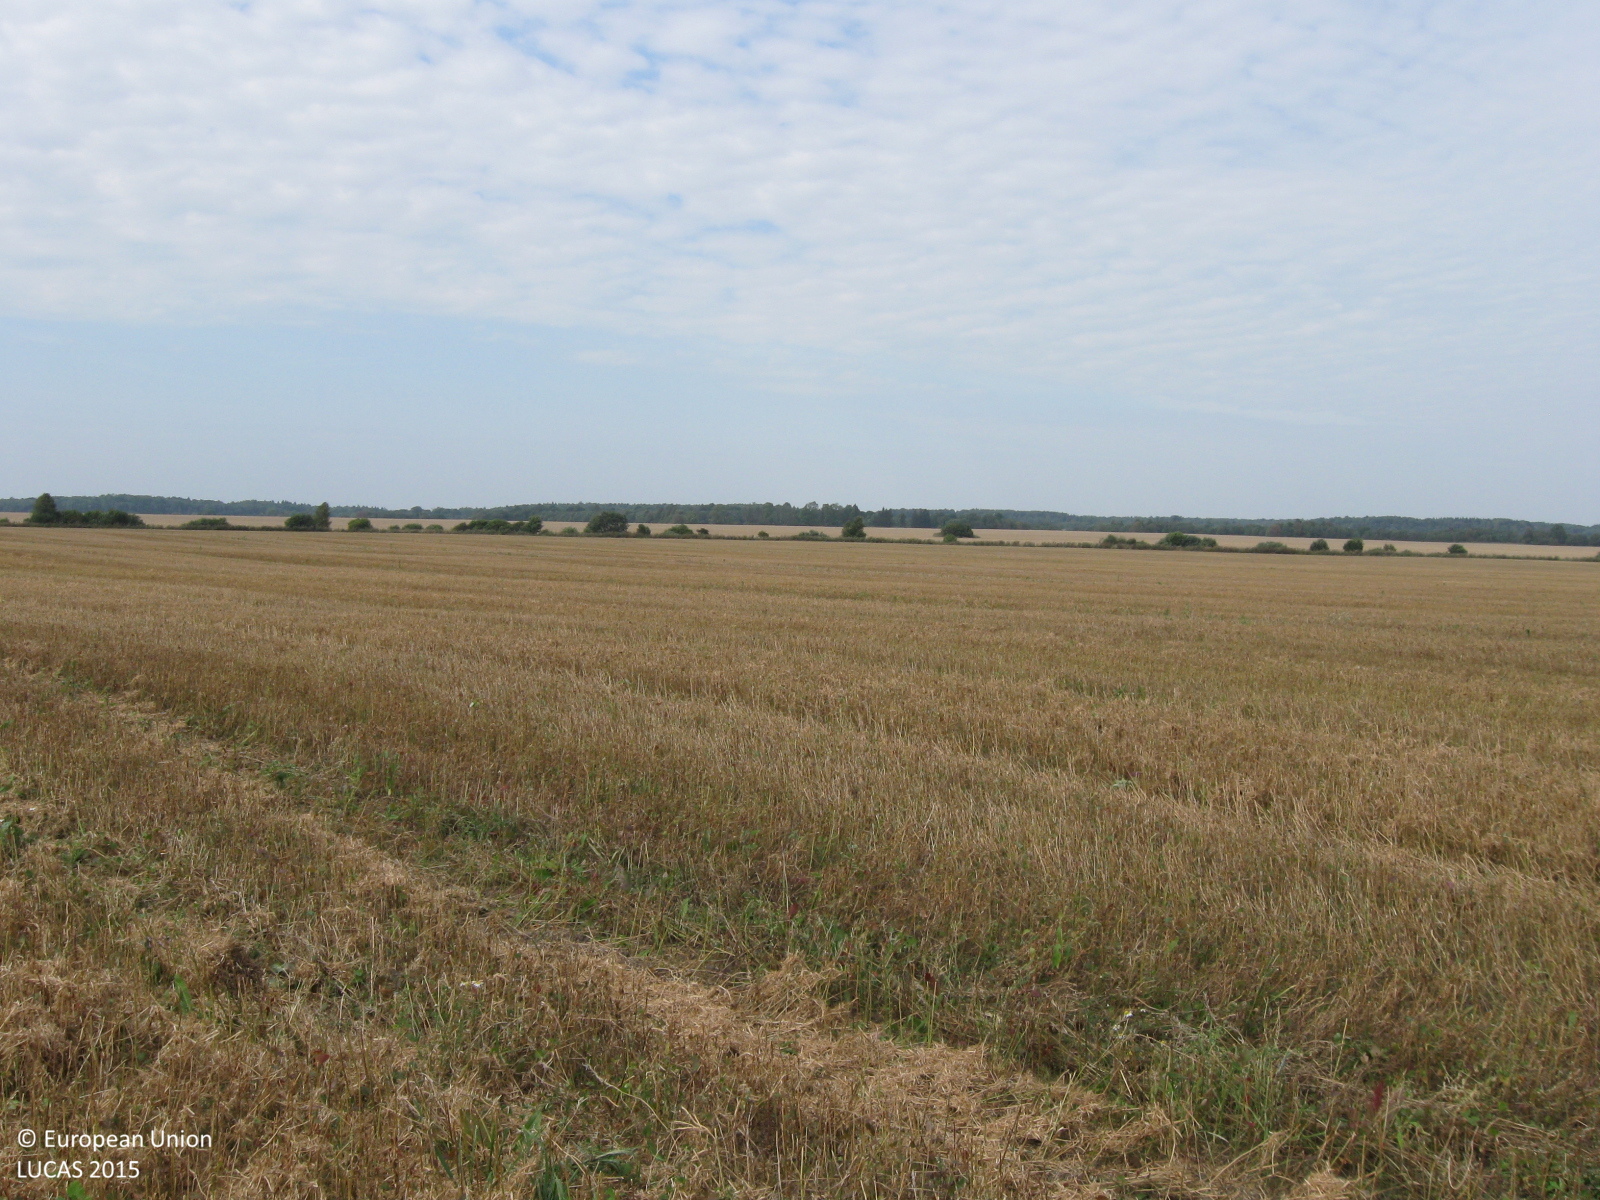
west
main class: Cropland
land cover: Dry pulses
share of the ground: > 75 %
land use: Agriculture (excluding fallow land and kitchen gardens)
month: August
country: LT
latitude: 55.4688
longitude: 22.9931
